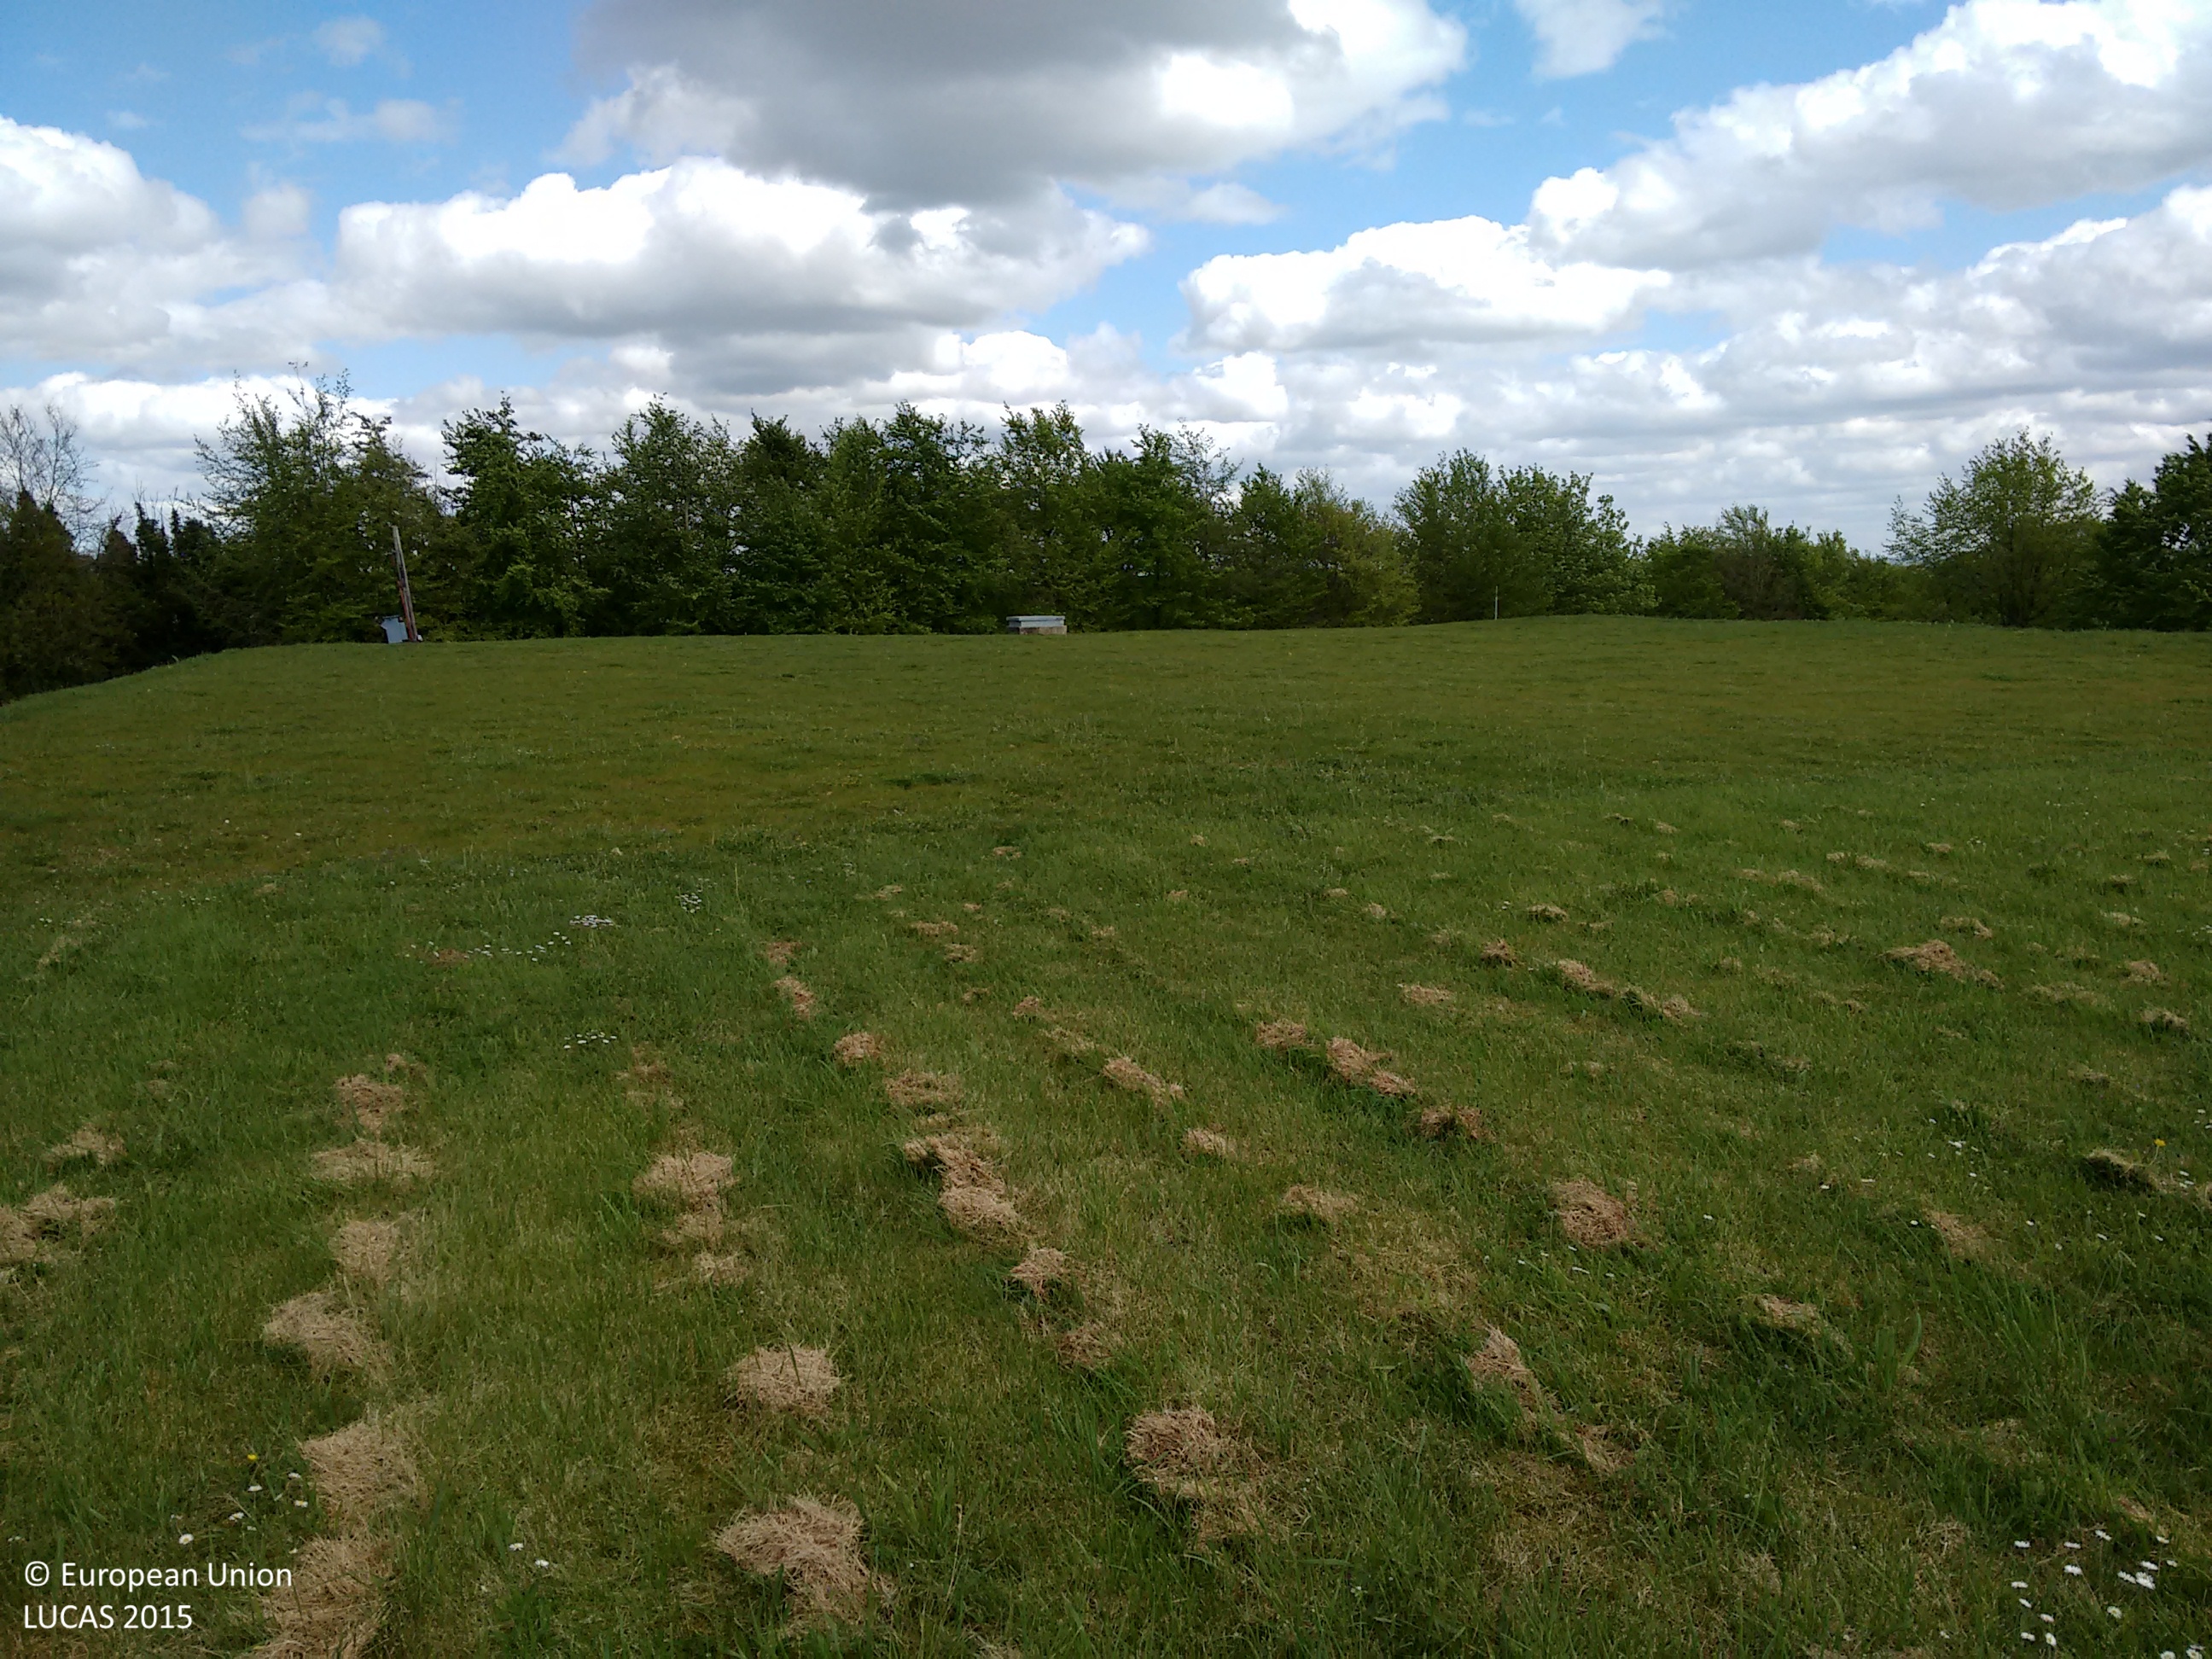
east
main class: Grassland
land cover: Grassland without tree/shrub cover
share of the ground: > 75 %
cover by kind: herbaceous plants 100 %
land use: Semi-natural and natural areas not in use
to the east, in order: Grassland without tree/shrub cover; Fences; Broadleaved woodland; Paved roads, cycling and walking lanes; Broadleaved woodland; Barley
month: May
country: GB
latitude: 51.2867
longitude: -1.1589
